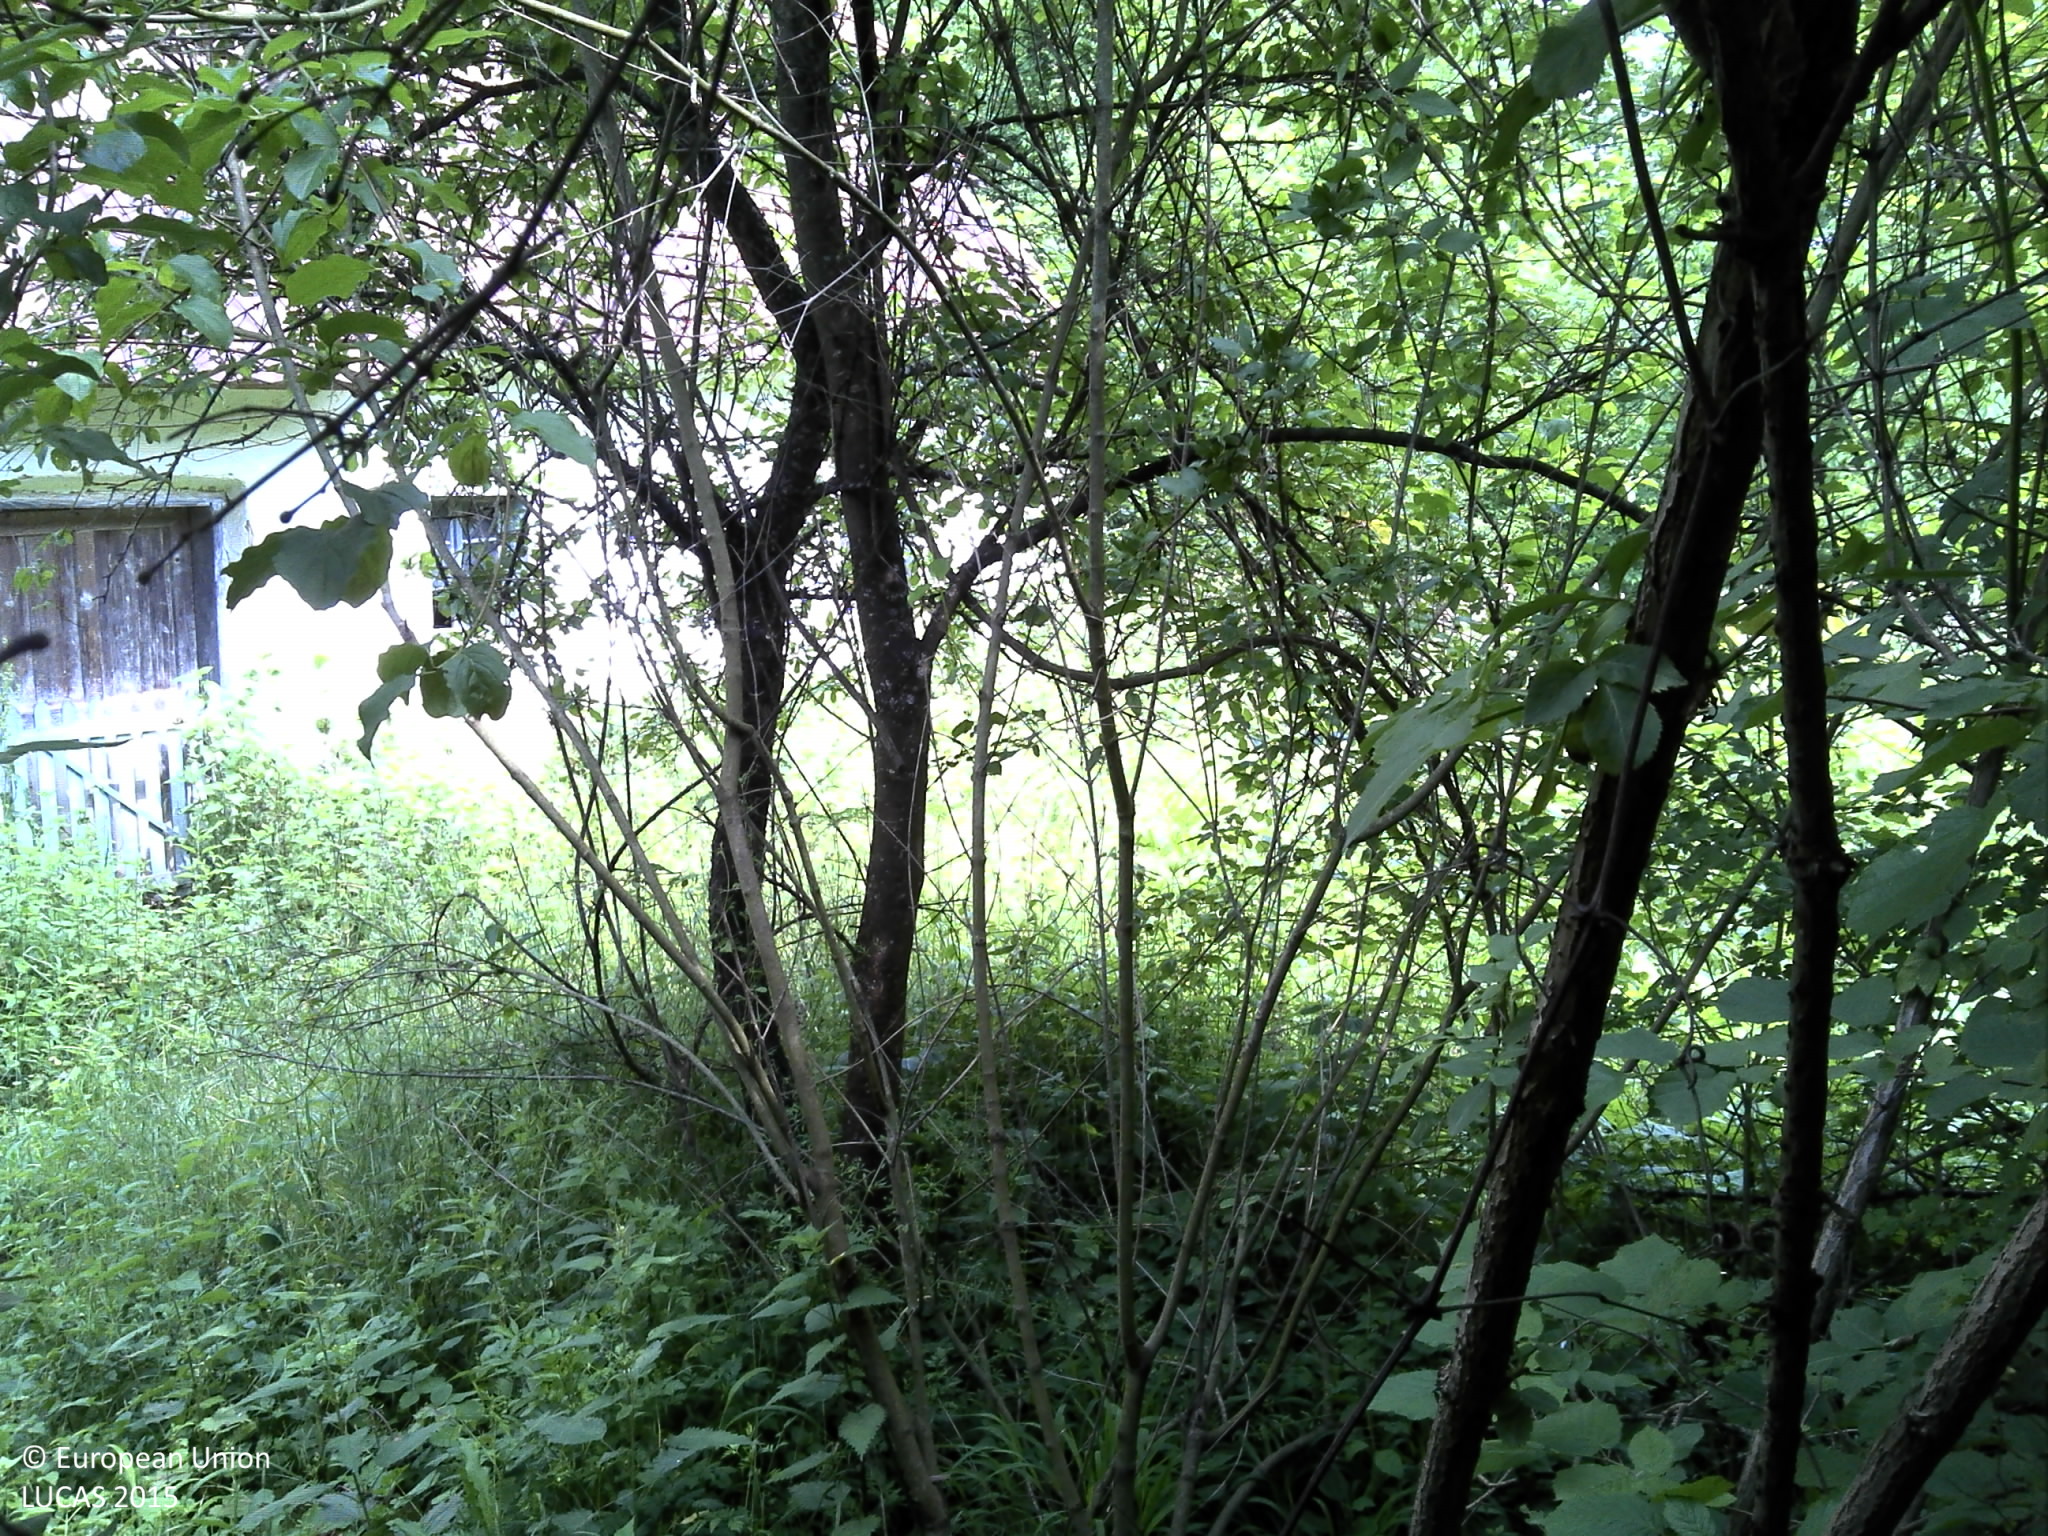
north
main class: Shrubland
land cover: Shrubland with sparse tree cover
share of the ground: > 75 %
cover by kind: shrubs 95 %, broadleaved forest trees 5 %
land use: Semi-natural and natural areas not in use
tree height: < 5 m
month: May
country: HR
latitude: 45.3187
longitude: 17.8733
